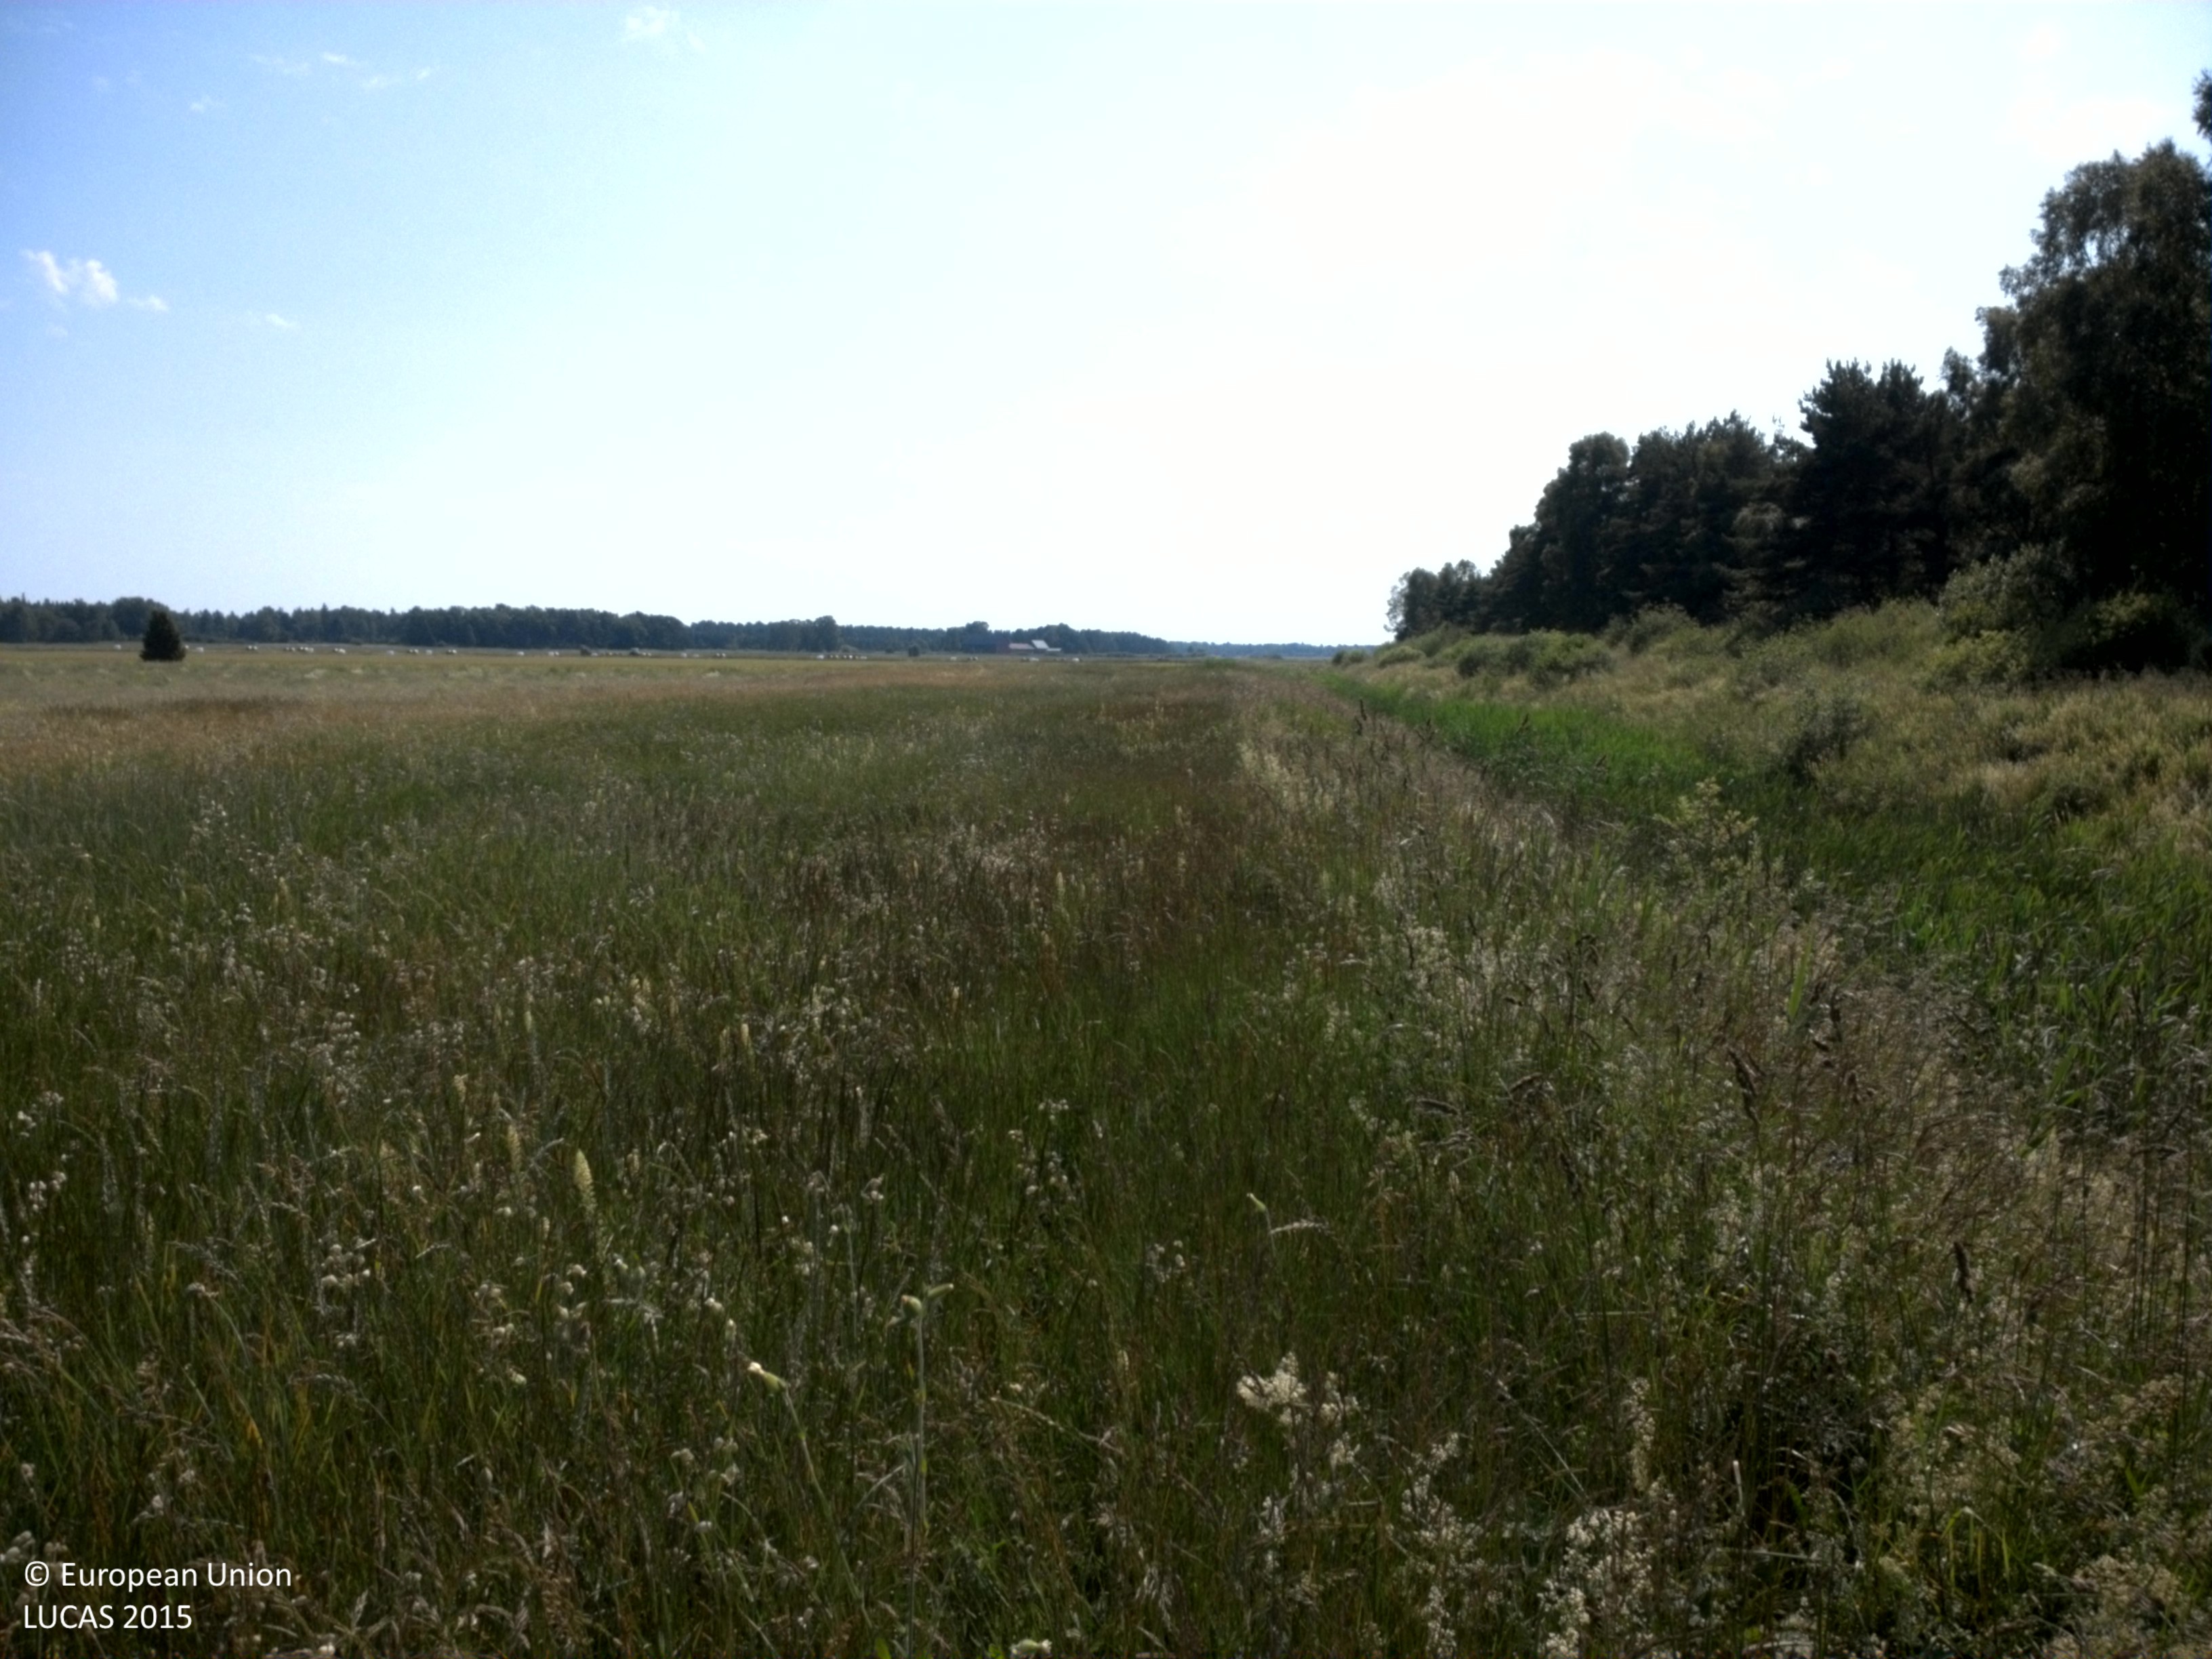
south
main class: Grassland
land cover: Spontaneously vegetated surfaces
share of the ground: > 75 %
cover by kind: herbaceous plants 95 %, shrubs 5 %
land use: Agriculture (excluding fallow land and kitchen gardens)
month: July
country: SE
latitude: 57.7293
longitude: 18.5556
